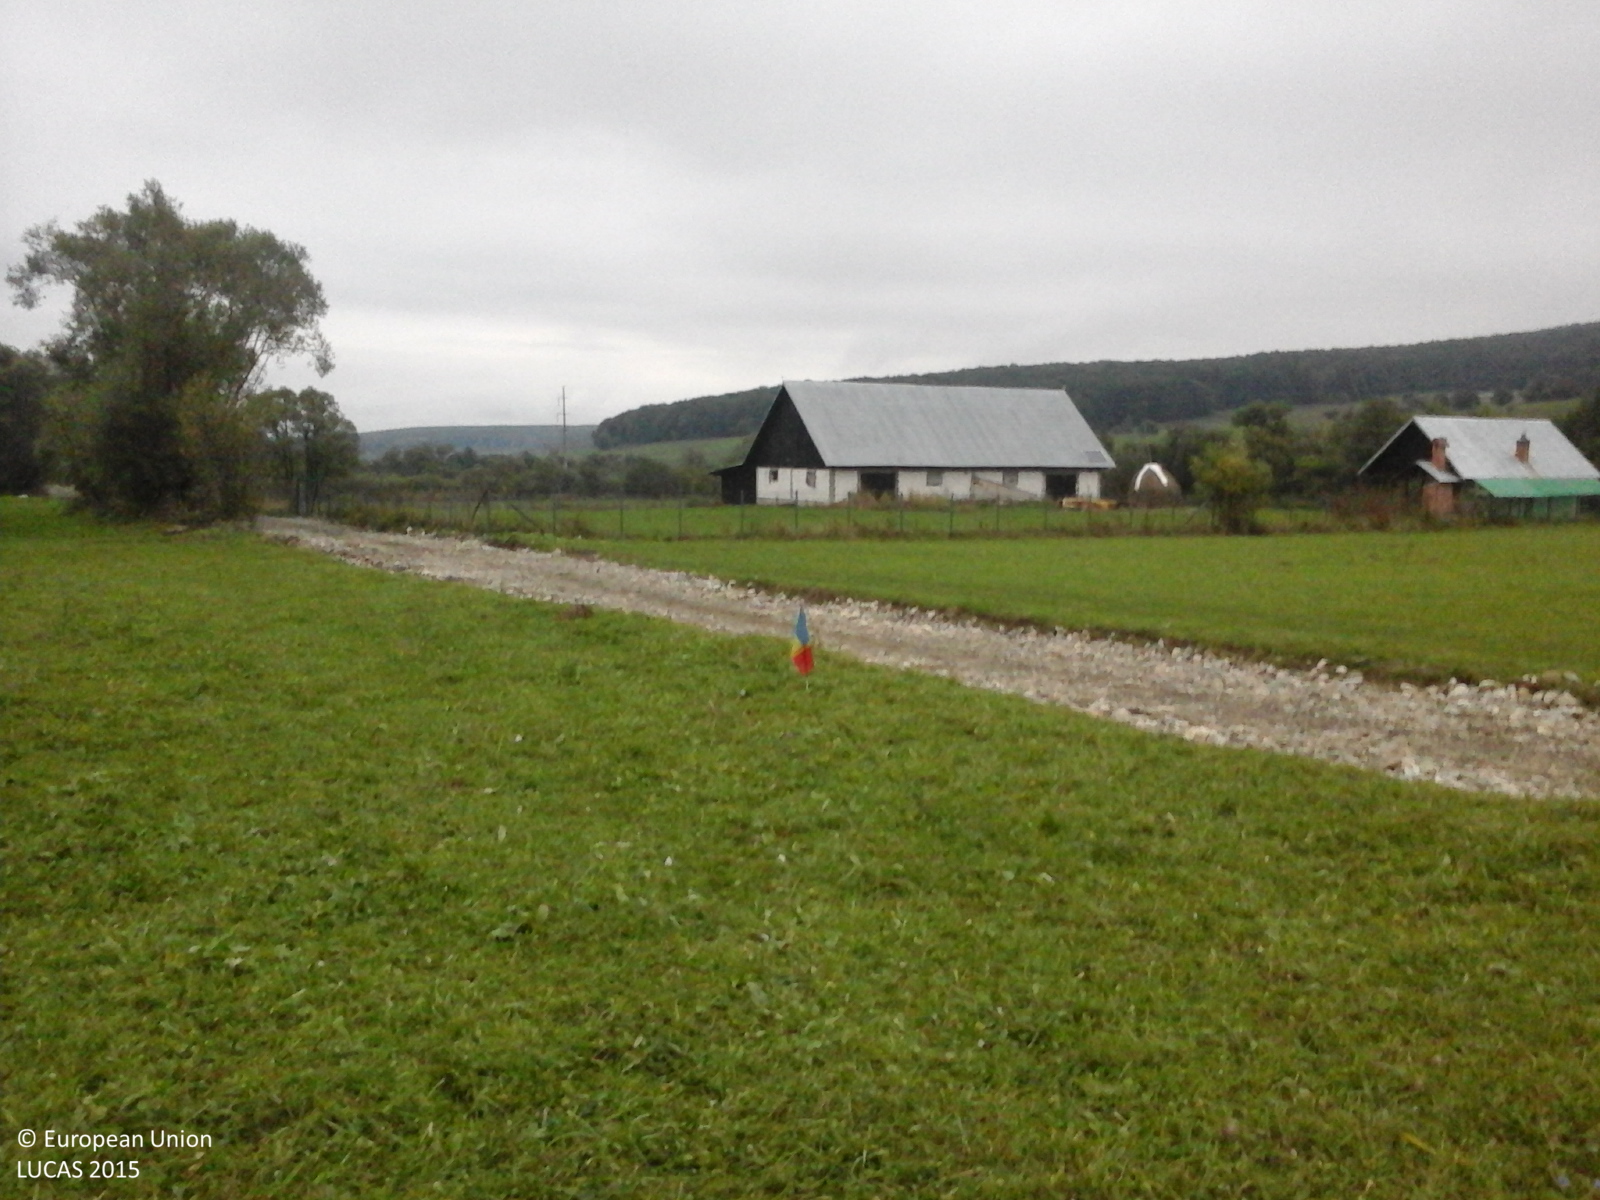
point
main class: Grassland
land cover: Grassland without tree/shrub cover
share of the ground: > 75 %
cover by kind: herbaceous plants 100 %
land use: Agriculture (excluding fallow land and kitchen gardens)
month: October
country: RO
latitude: 45.6955
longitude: 24.1622
